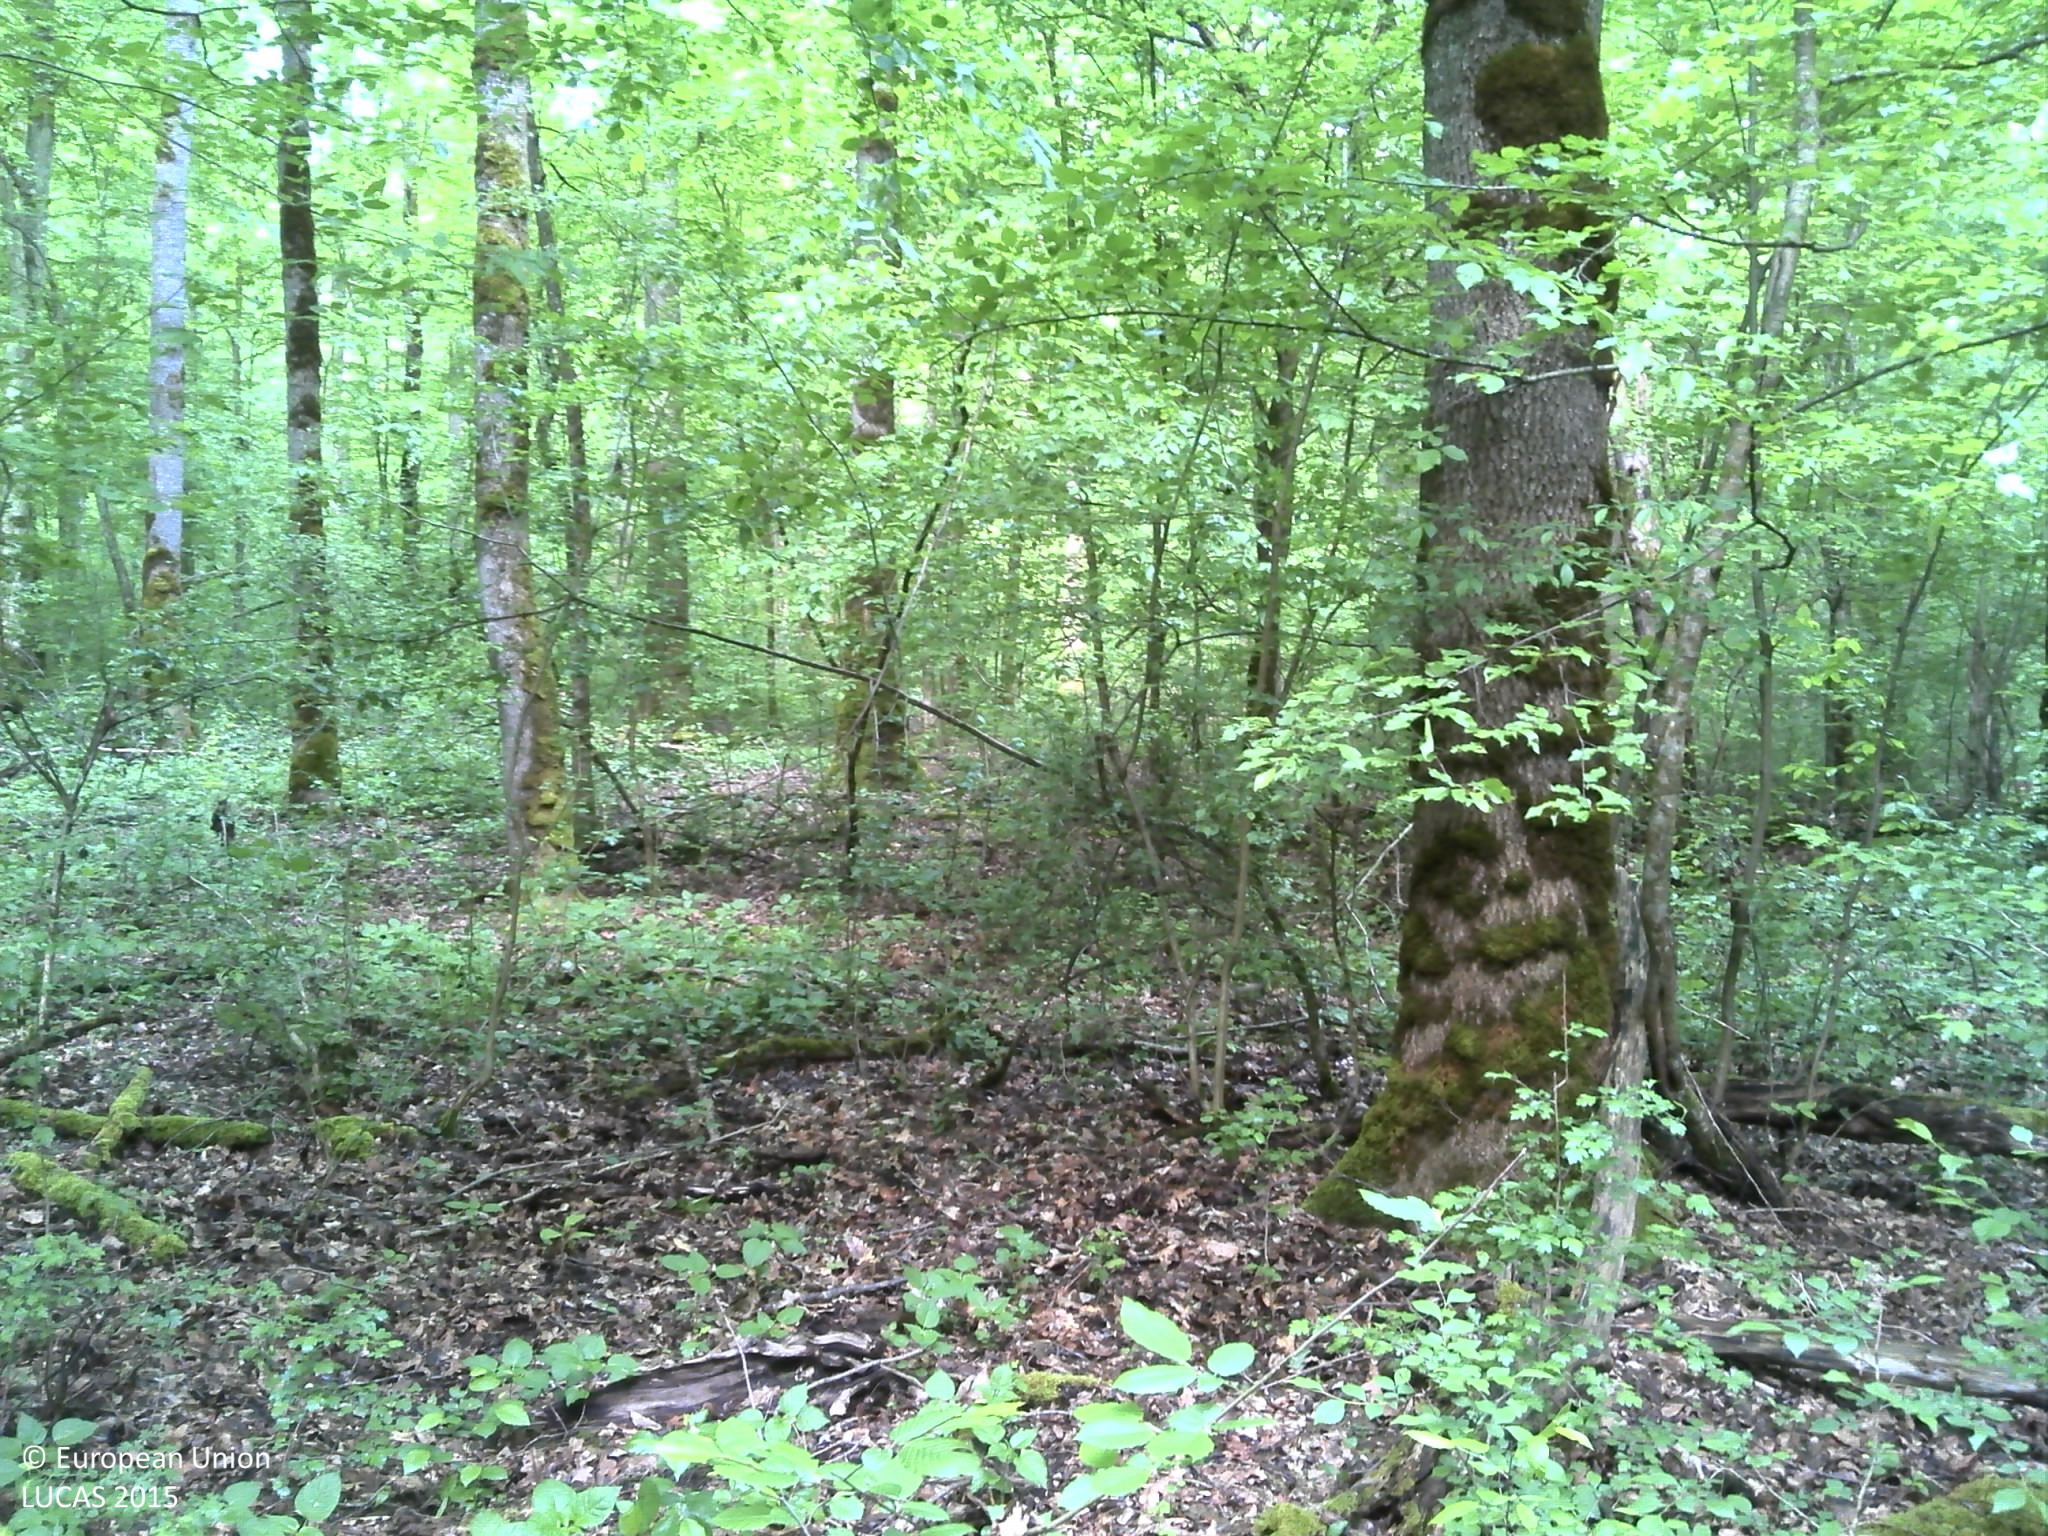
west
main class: Woodland
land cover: Broadleaved woodland
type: mesophytic deciduous forest
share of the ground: > 75 %
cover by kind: broadleaved forest trees 100 %
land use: Forestry
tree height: > 5 m
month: May
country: HR
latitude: 45.0347
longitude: 18.9304
